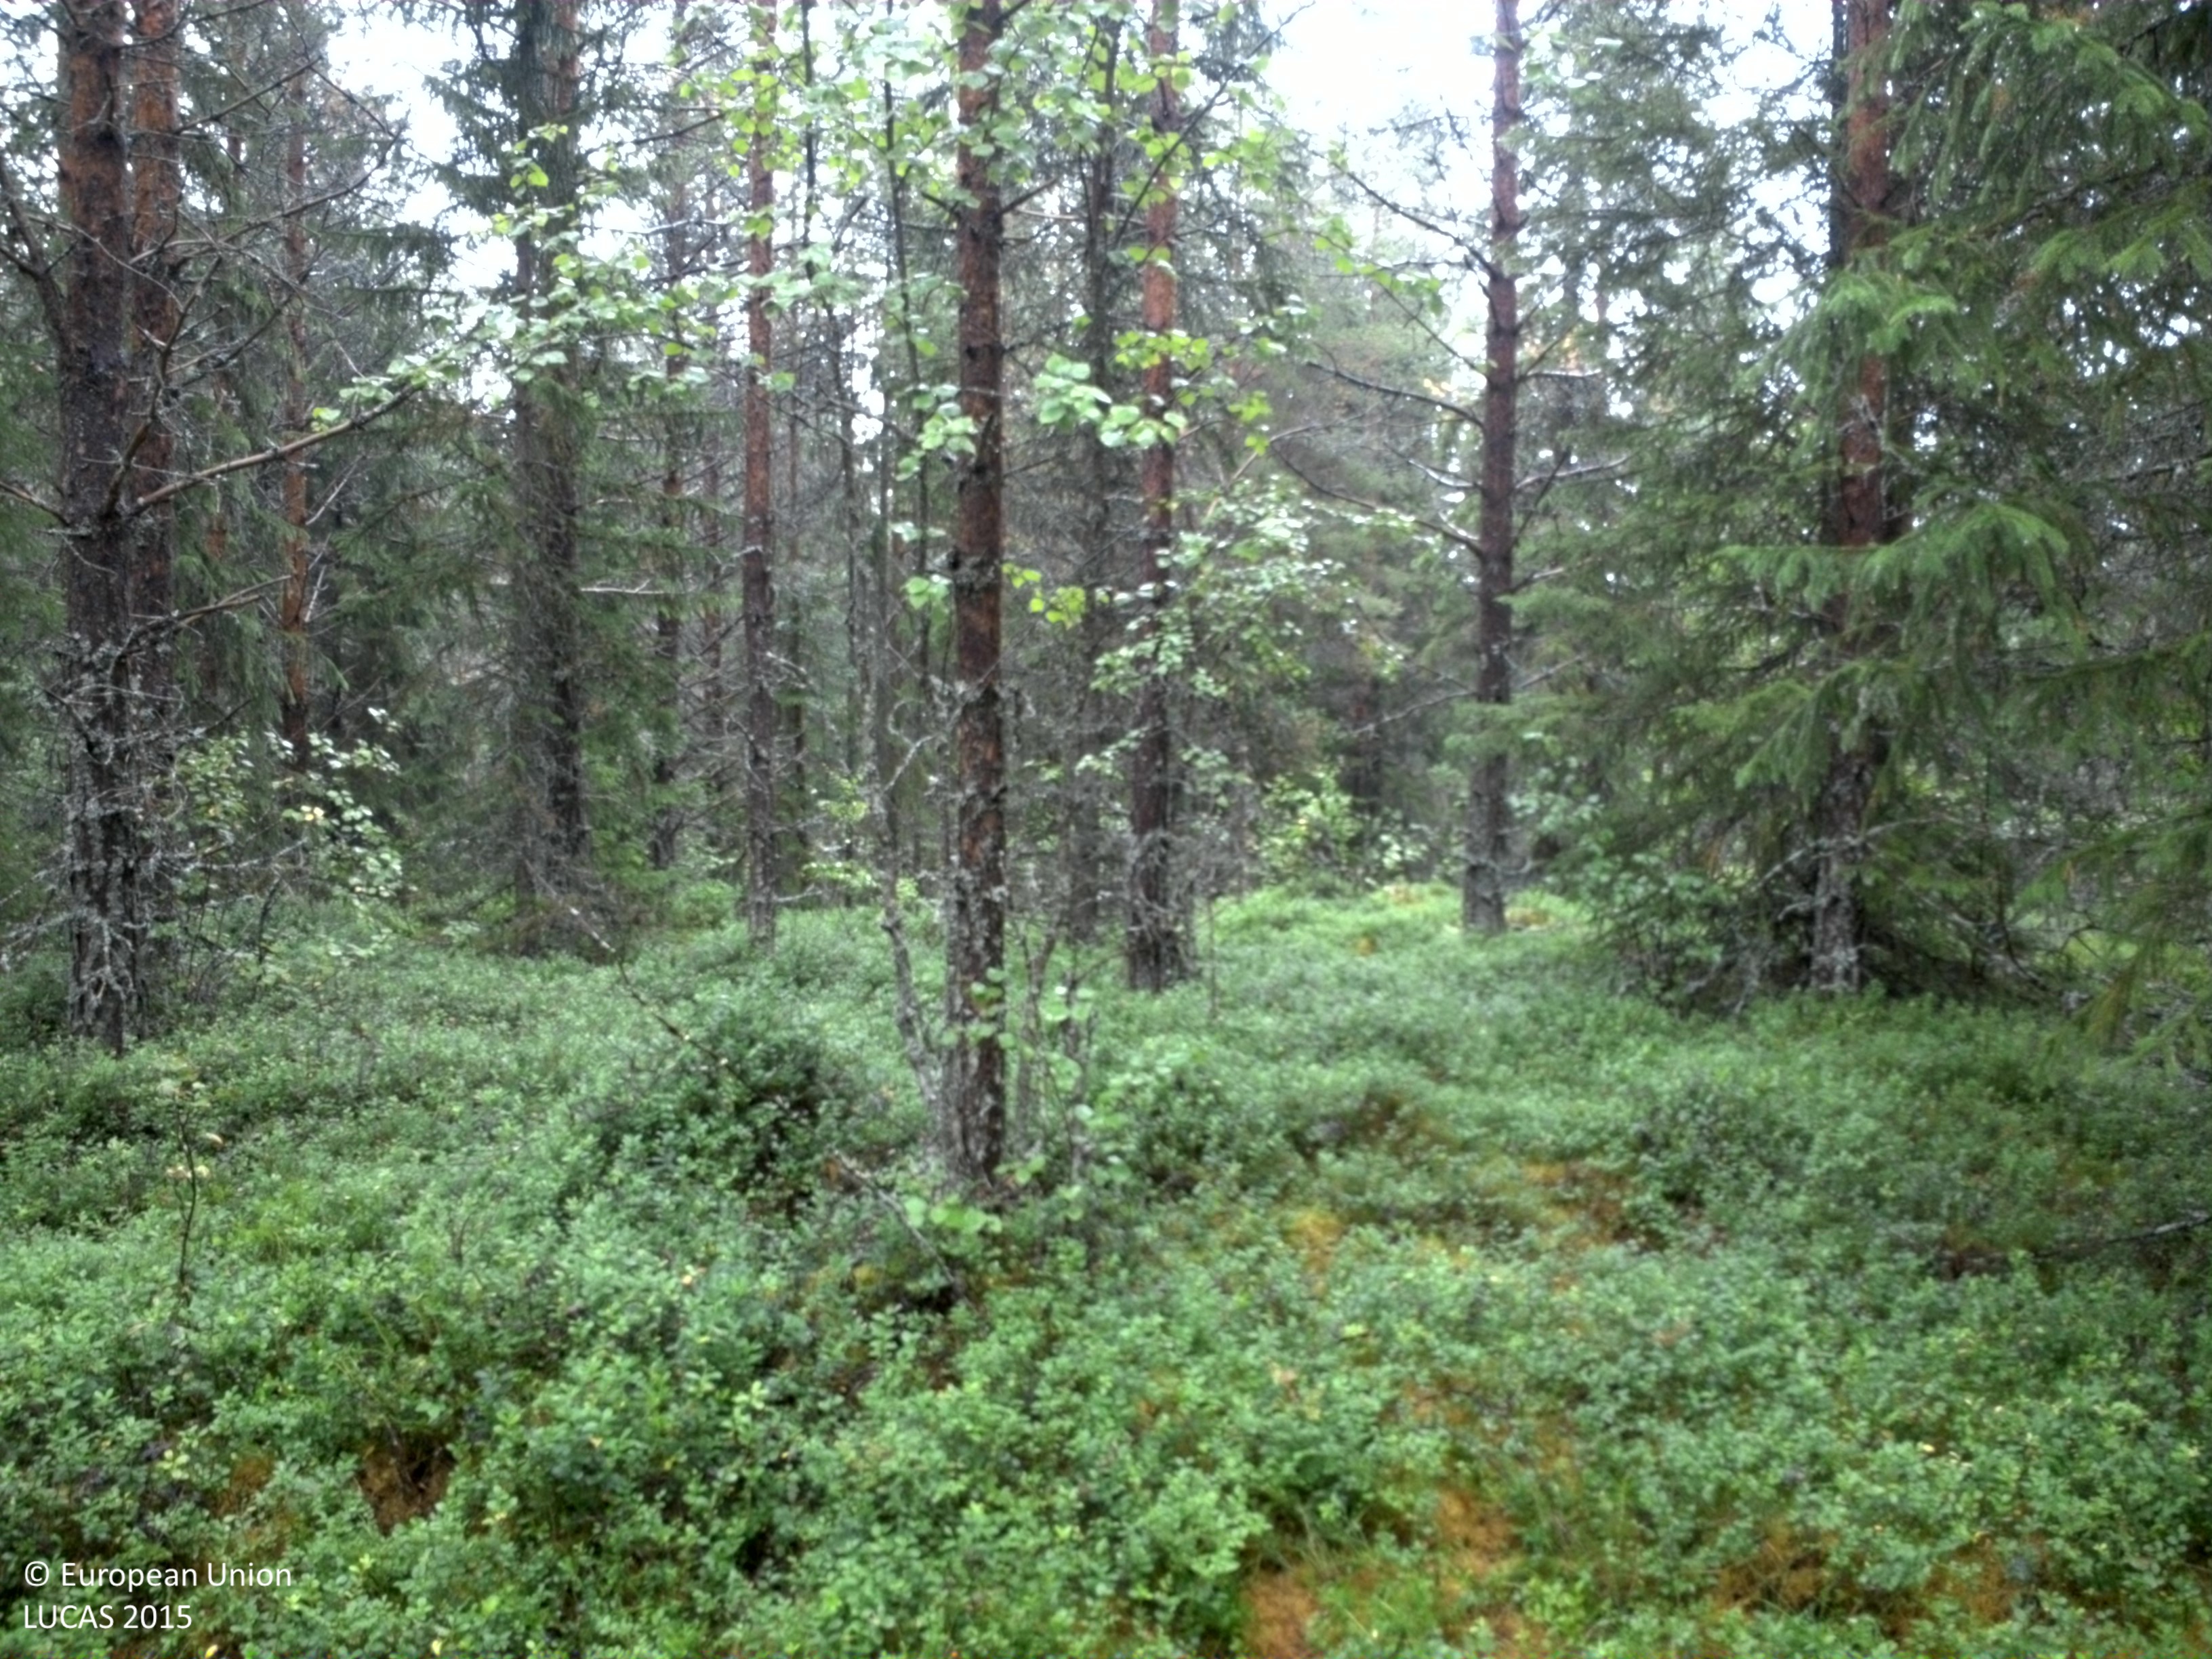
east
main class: Woodland
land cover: Pine dominated coniferous woodland
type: boreal forest
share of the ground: 50 - 75 %
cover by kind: coniferous forest trees 50 %, shrubs 25 %, lichens and mosses 15 %, broadleaved forest trees 10 %
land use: Forestry
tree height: > 5 m
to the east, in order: Pine dominated coniferous woodland; Spruce dominated mixed woodland; Rivers and streams; Other mixed woodland; Pine dominated coniferous woodland; Inland marshes
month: August
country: SE
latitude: 61.7884
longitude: 15.0084
